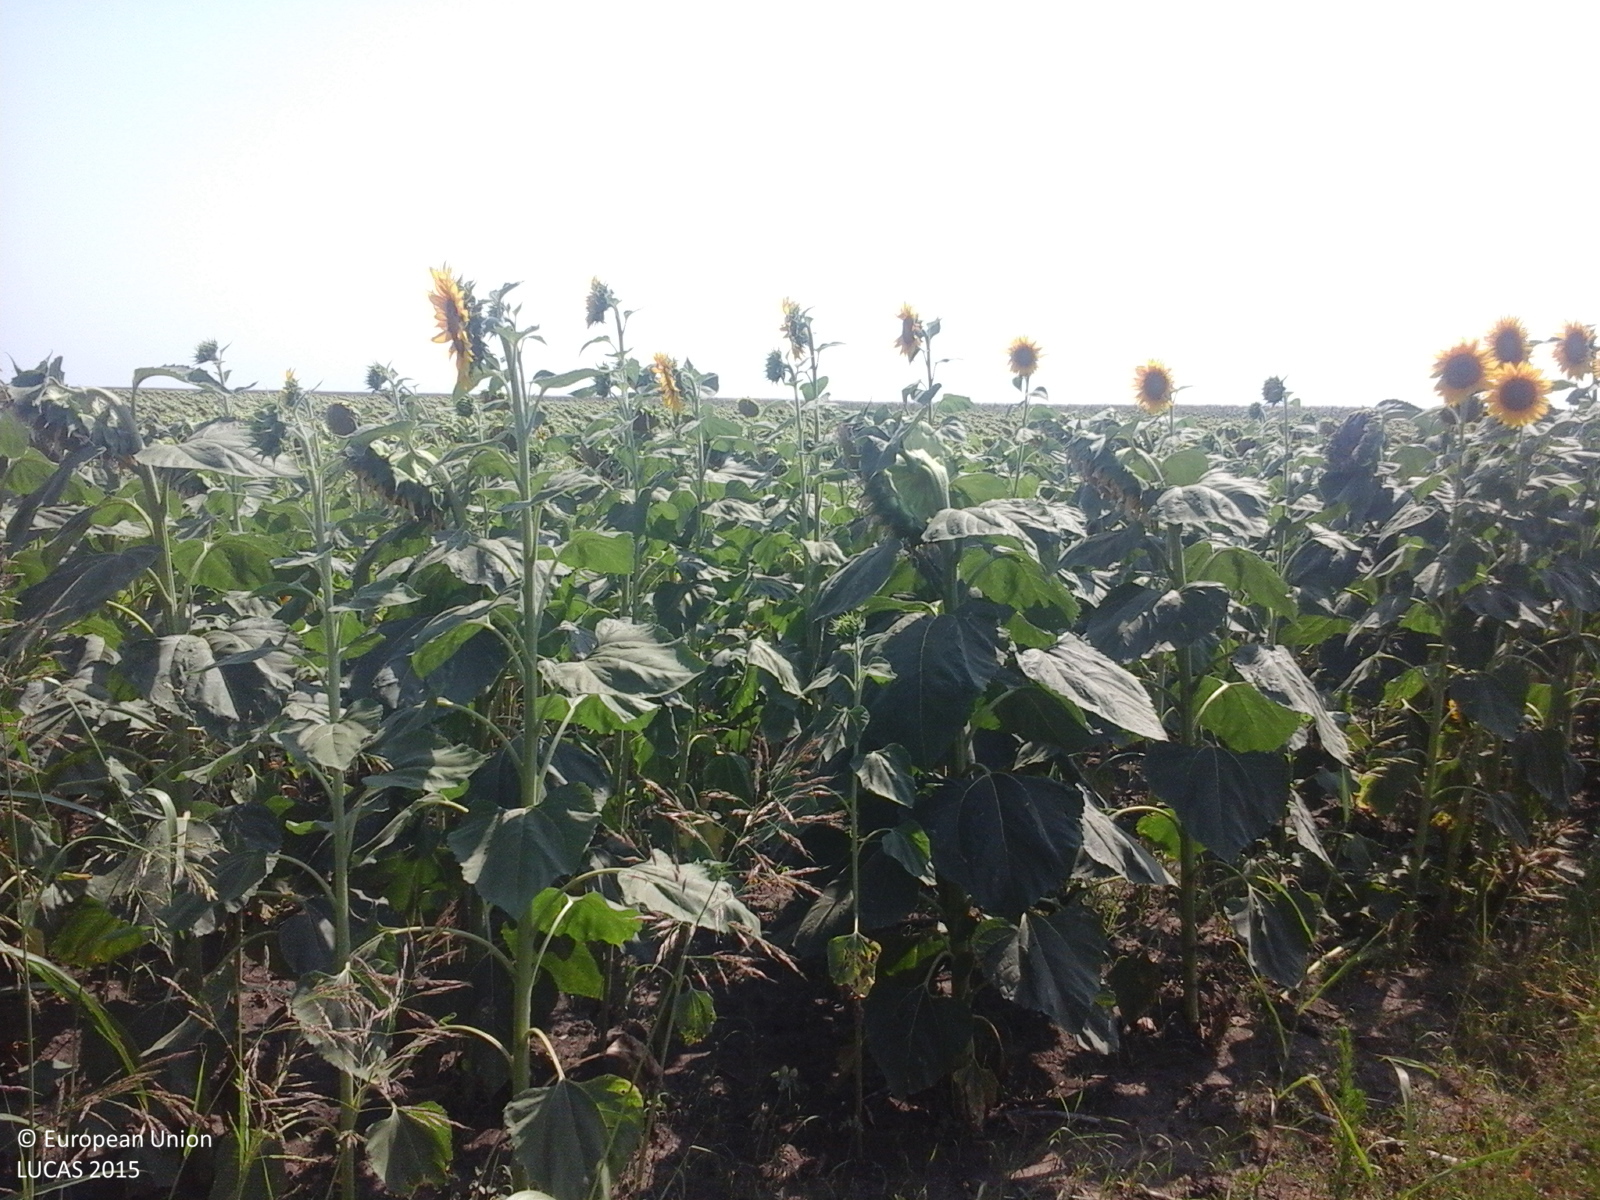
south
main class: Cropland
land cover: Sunflower
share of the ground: > 75 %
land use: Agriculture (excluding fallow land and kitchen gardens)
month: July
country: RO
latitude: 45.6511
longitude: 27.5966
